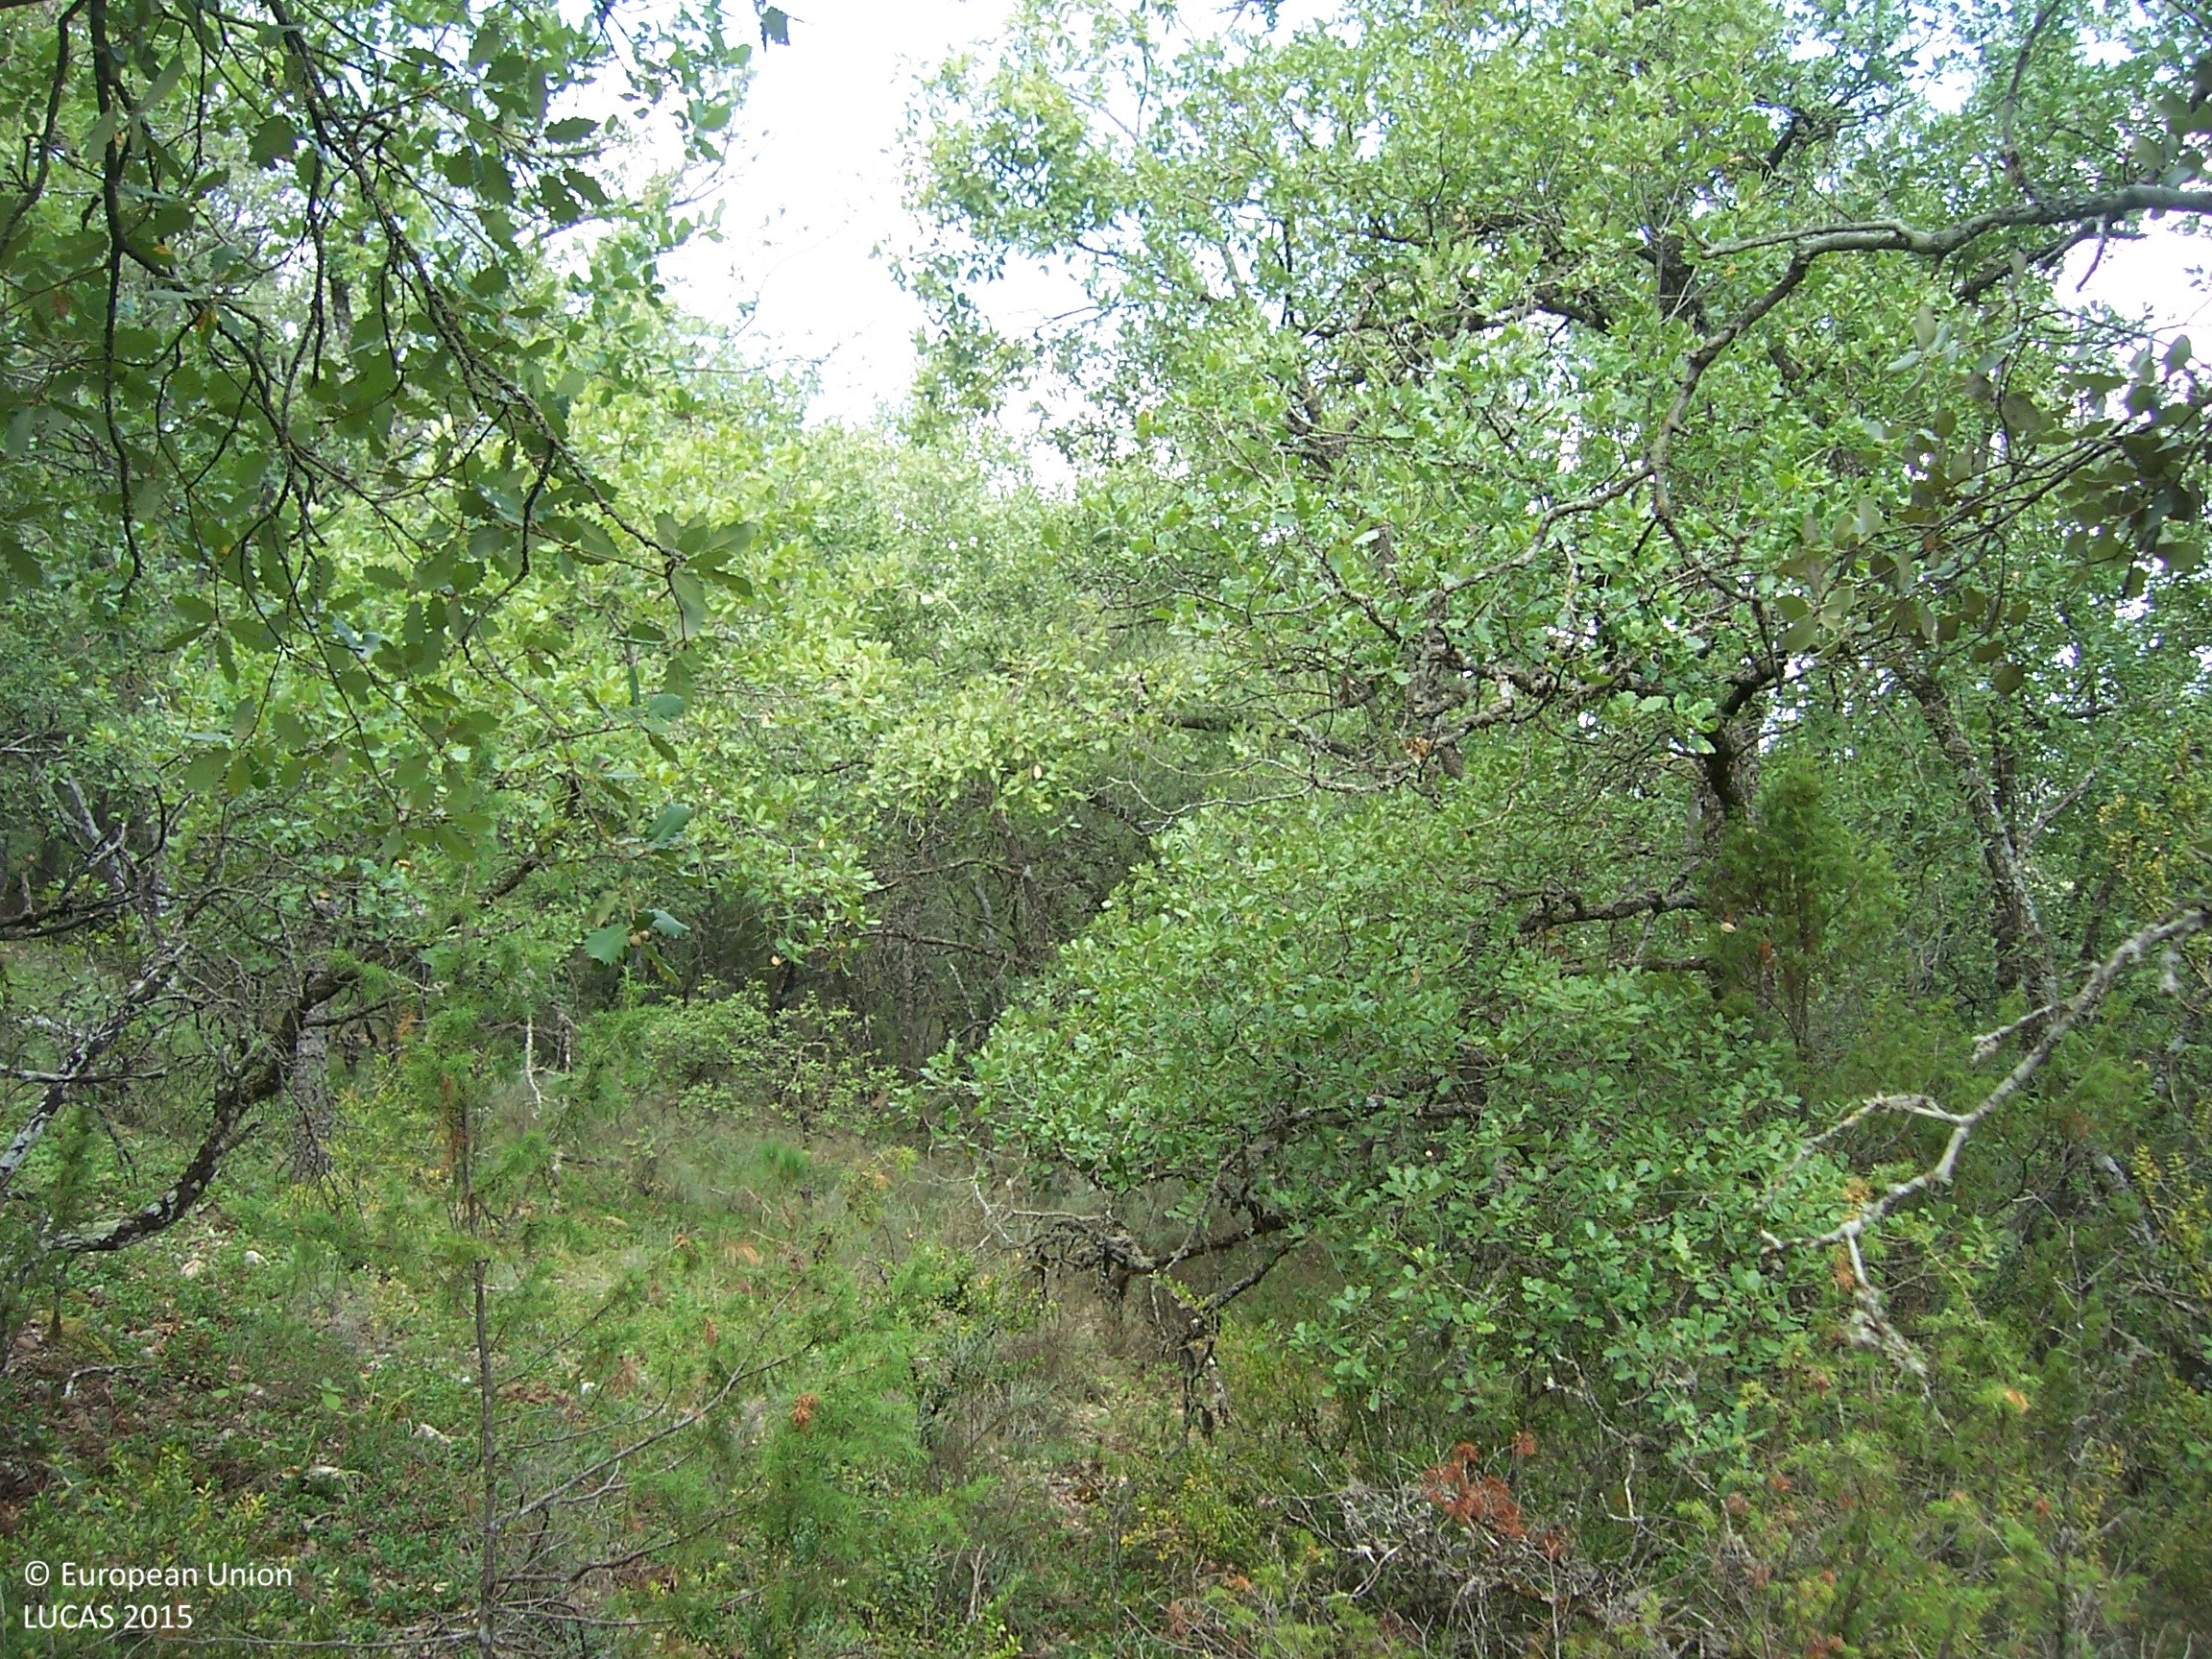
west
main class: Woodland
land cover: Broadleaved woodland
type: broadleaved evergreen forest
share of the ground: > 75 %
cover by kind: broadleaved forest trees 80 %, shrubs 10 %, herbaceous plants 10 %
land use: Semi-natural and natural areas not in use
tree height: > 5 m
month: August
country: ES
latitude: 42.0587
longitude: 0.4735
